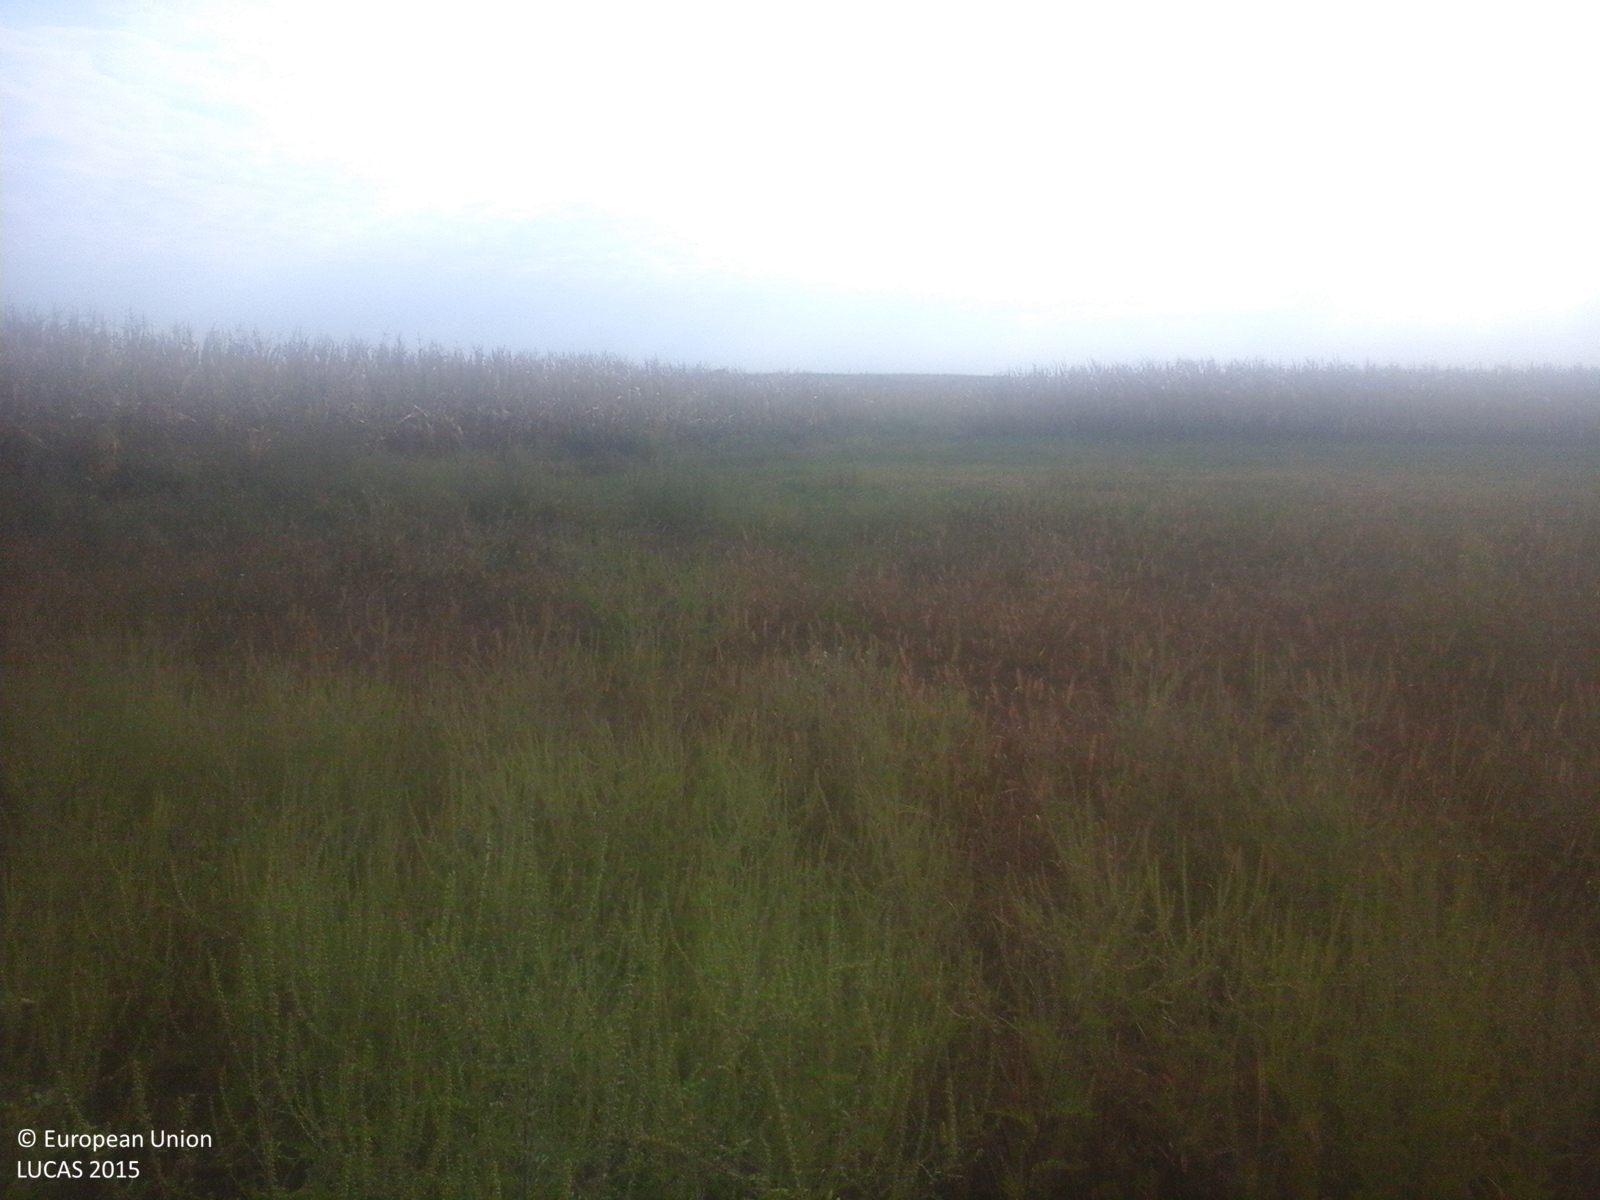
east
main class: Cropland
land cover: Maize
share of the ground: > 75 %
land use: Agriculture (excluding fallow land and kitchen gardens)
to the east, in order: Maize; Spontaneously vegetated surfaces; Lucerne; Tracks; Shruby margins; Maize; Shruby margins; Tracks; Shruby margins; Sunflower; Maize
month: September
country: RO
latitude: 47.7915
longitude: 22.7304
